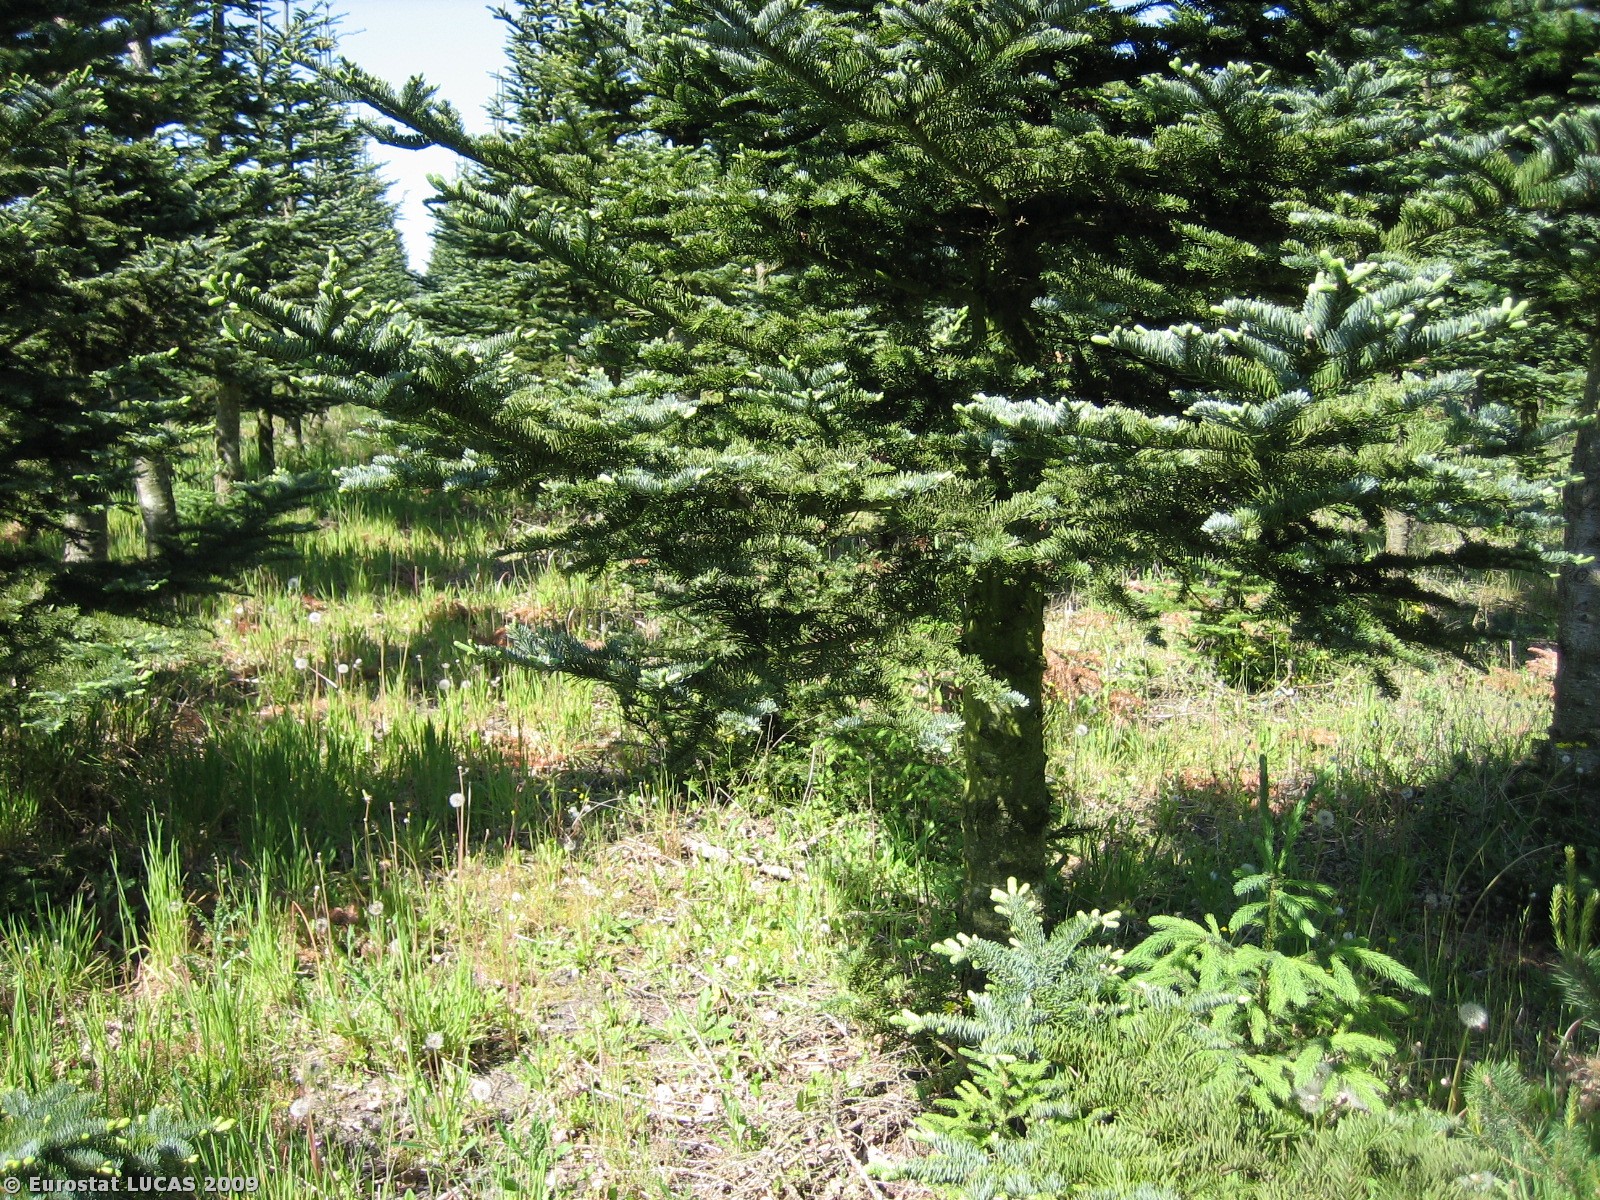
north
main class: Woodland
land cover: Coniferous woodland
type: hemiboreal forest and nemoral coniferous forest and mixed broadleaved-coniferous forest
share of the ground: 25 - 50 %
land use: Forestry
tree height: > 5 m
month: May
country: DK
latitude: 55.8782
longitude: 8.9940
